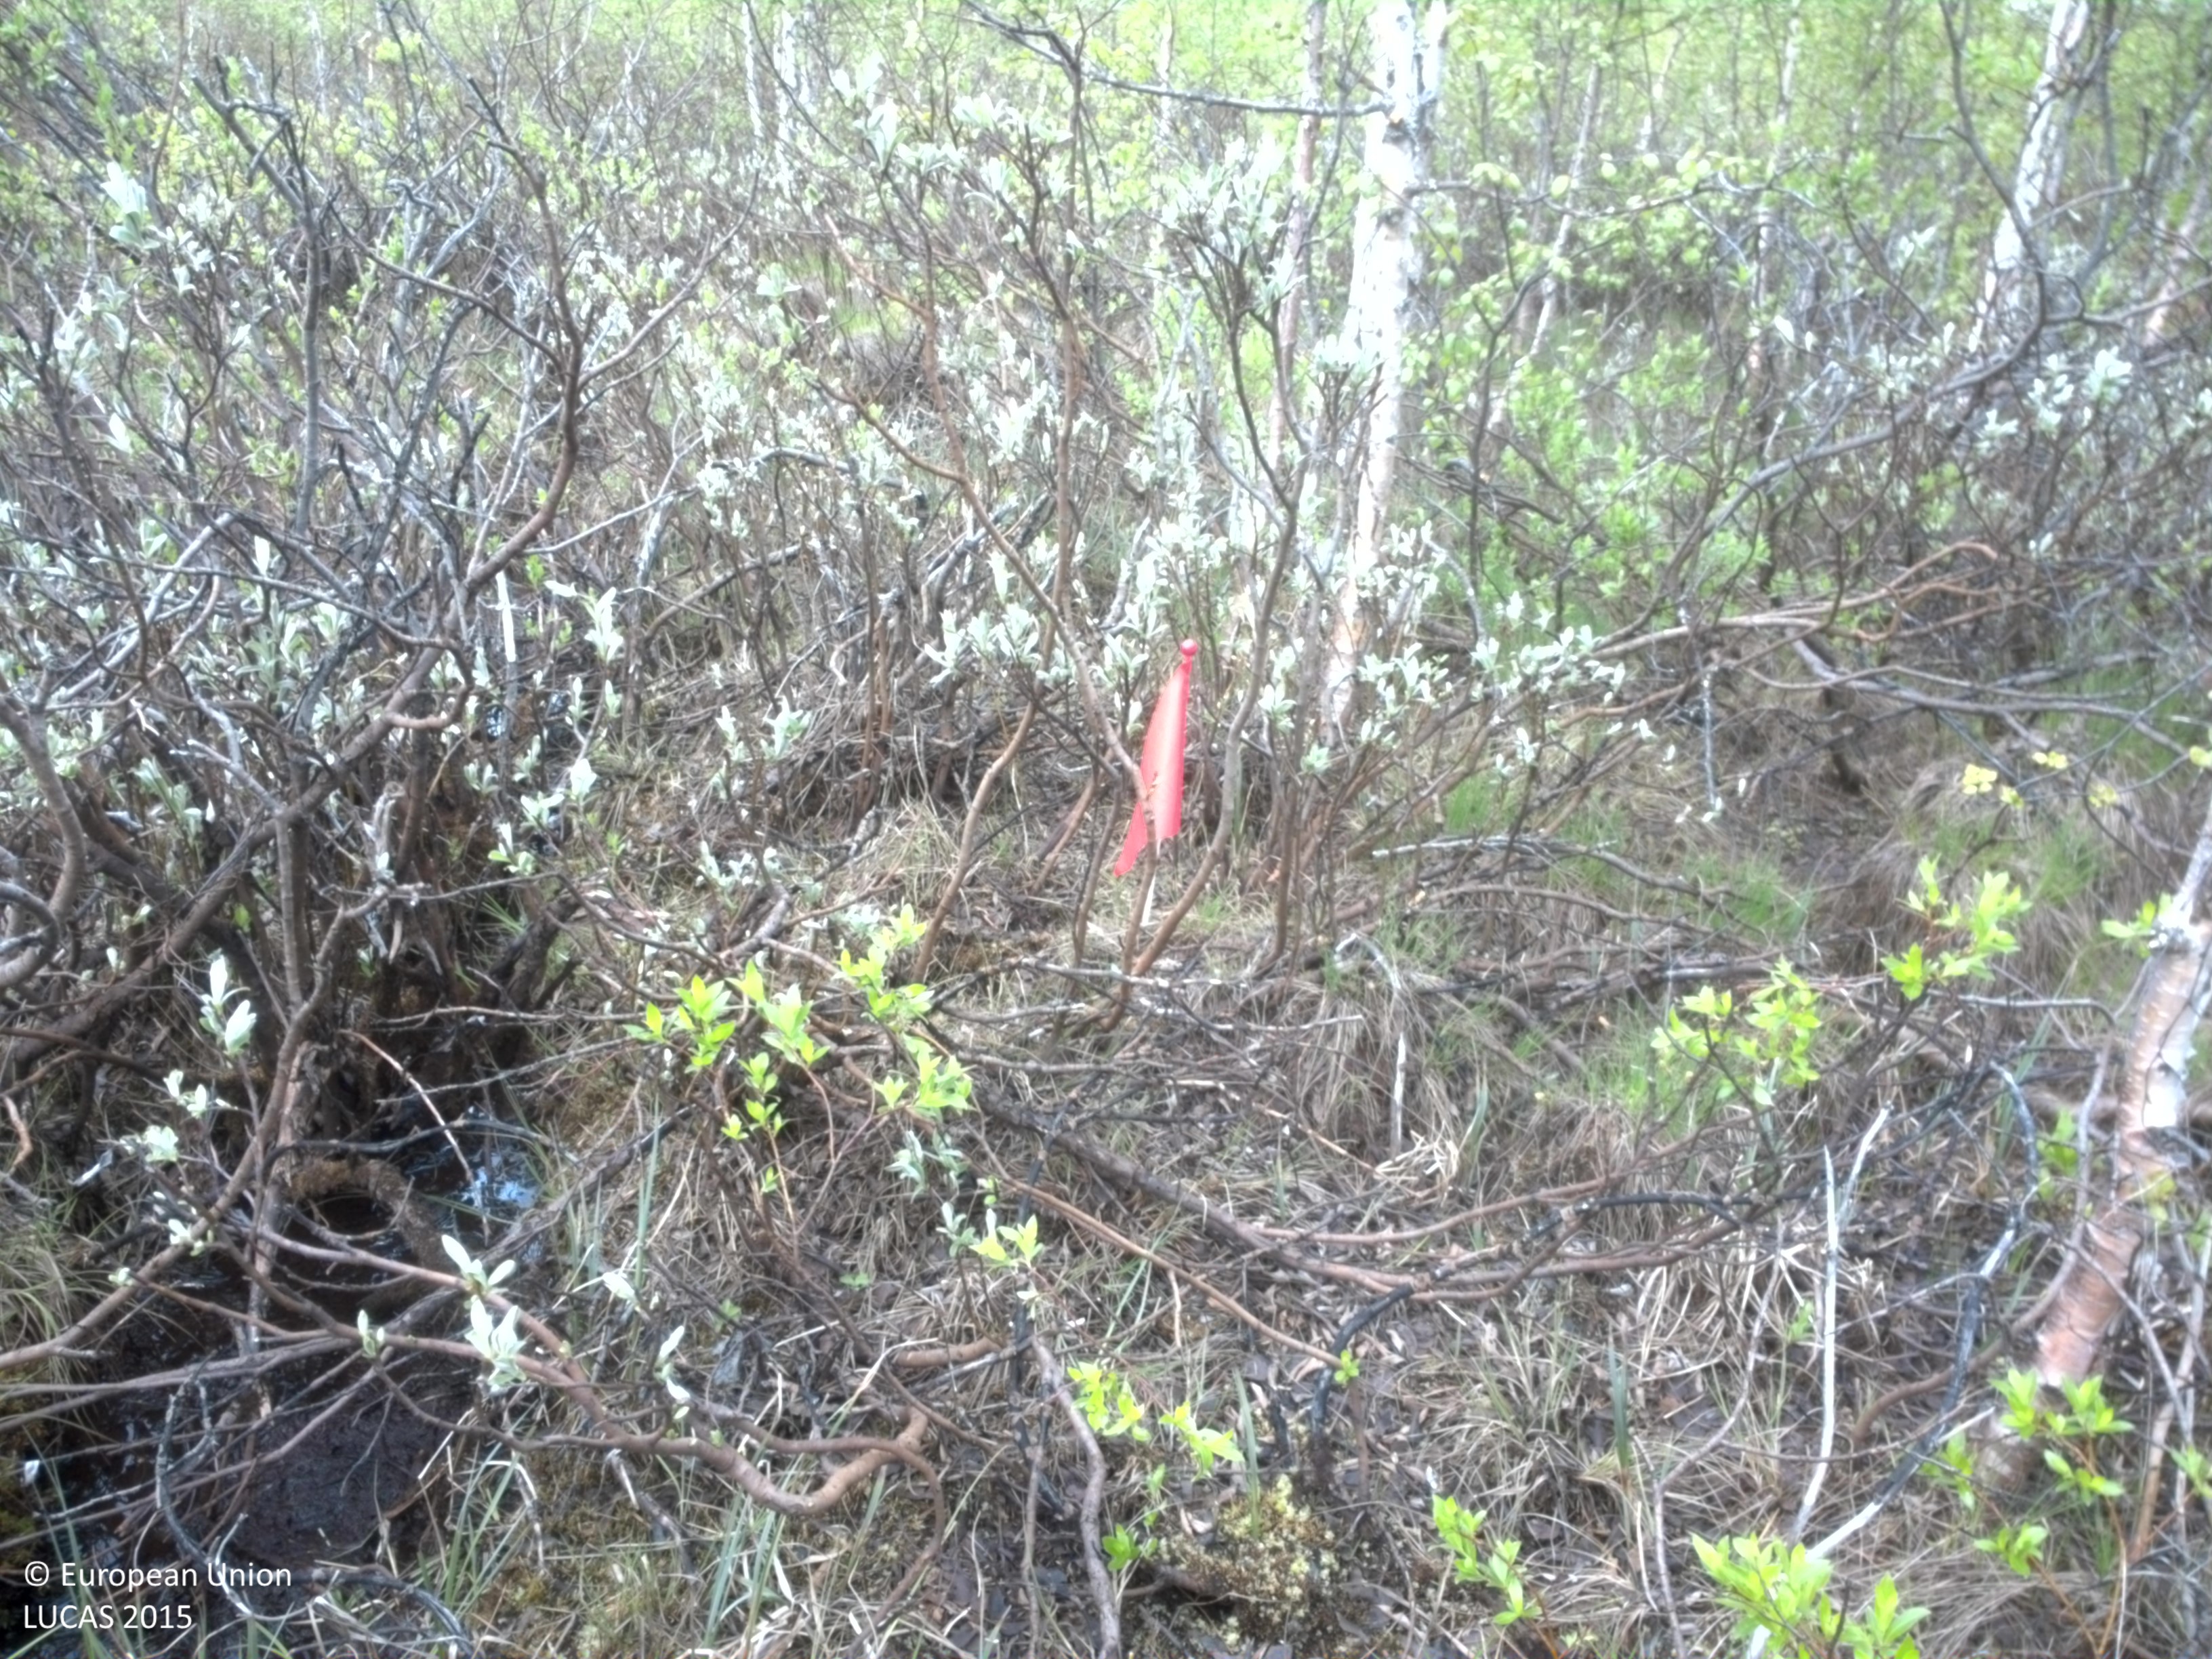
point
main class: Woodland
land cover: Broadleaved woodland
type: boreal forest
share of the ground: 25 - 50 %
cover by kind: shrubs 55 %, broadleaved forest trees 40 %, herbaceous plants 5 %
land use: Semi-natural and natural areas not in use
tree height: > 5 m
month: June
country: SE
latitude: 67.0127
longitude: 21.8681
